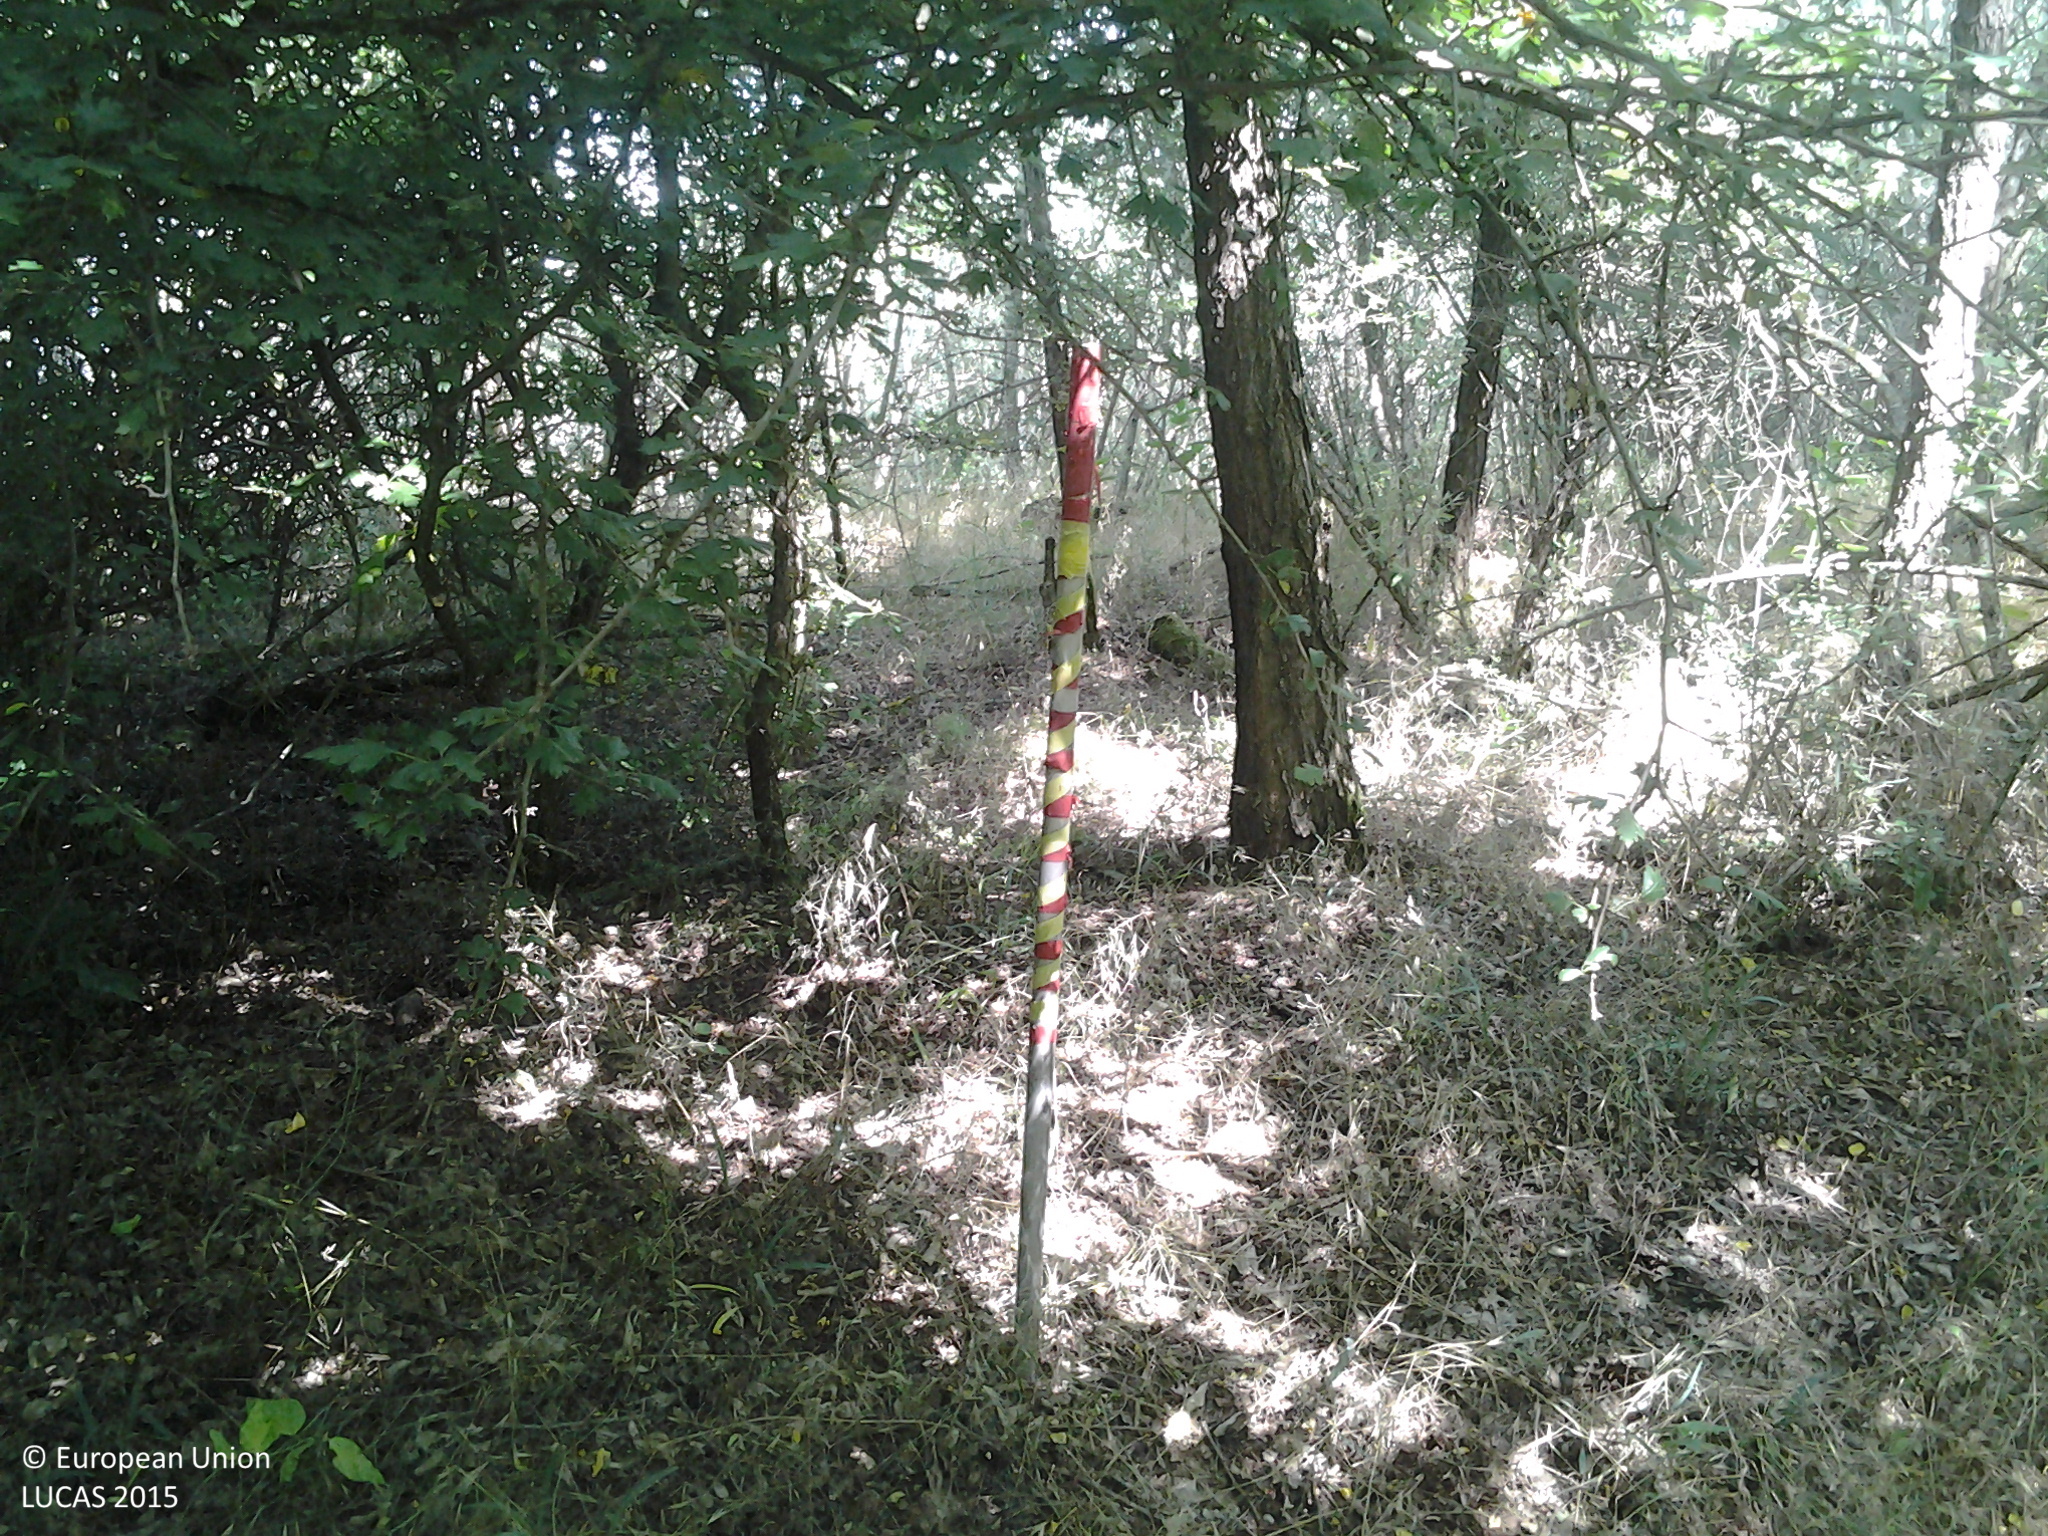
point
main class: Woodland
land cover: Broadleaved woodland
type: mesophytic deciduous forest
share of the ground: > 75 %
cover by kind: broadleaved forest trees 95 %, shrubs 5 %
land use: Forestry
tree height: > 5 m
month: June
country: HU
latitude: 46.8047
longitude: 19.6246
